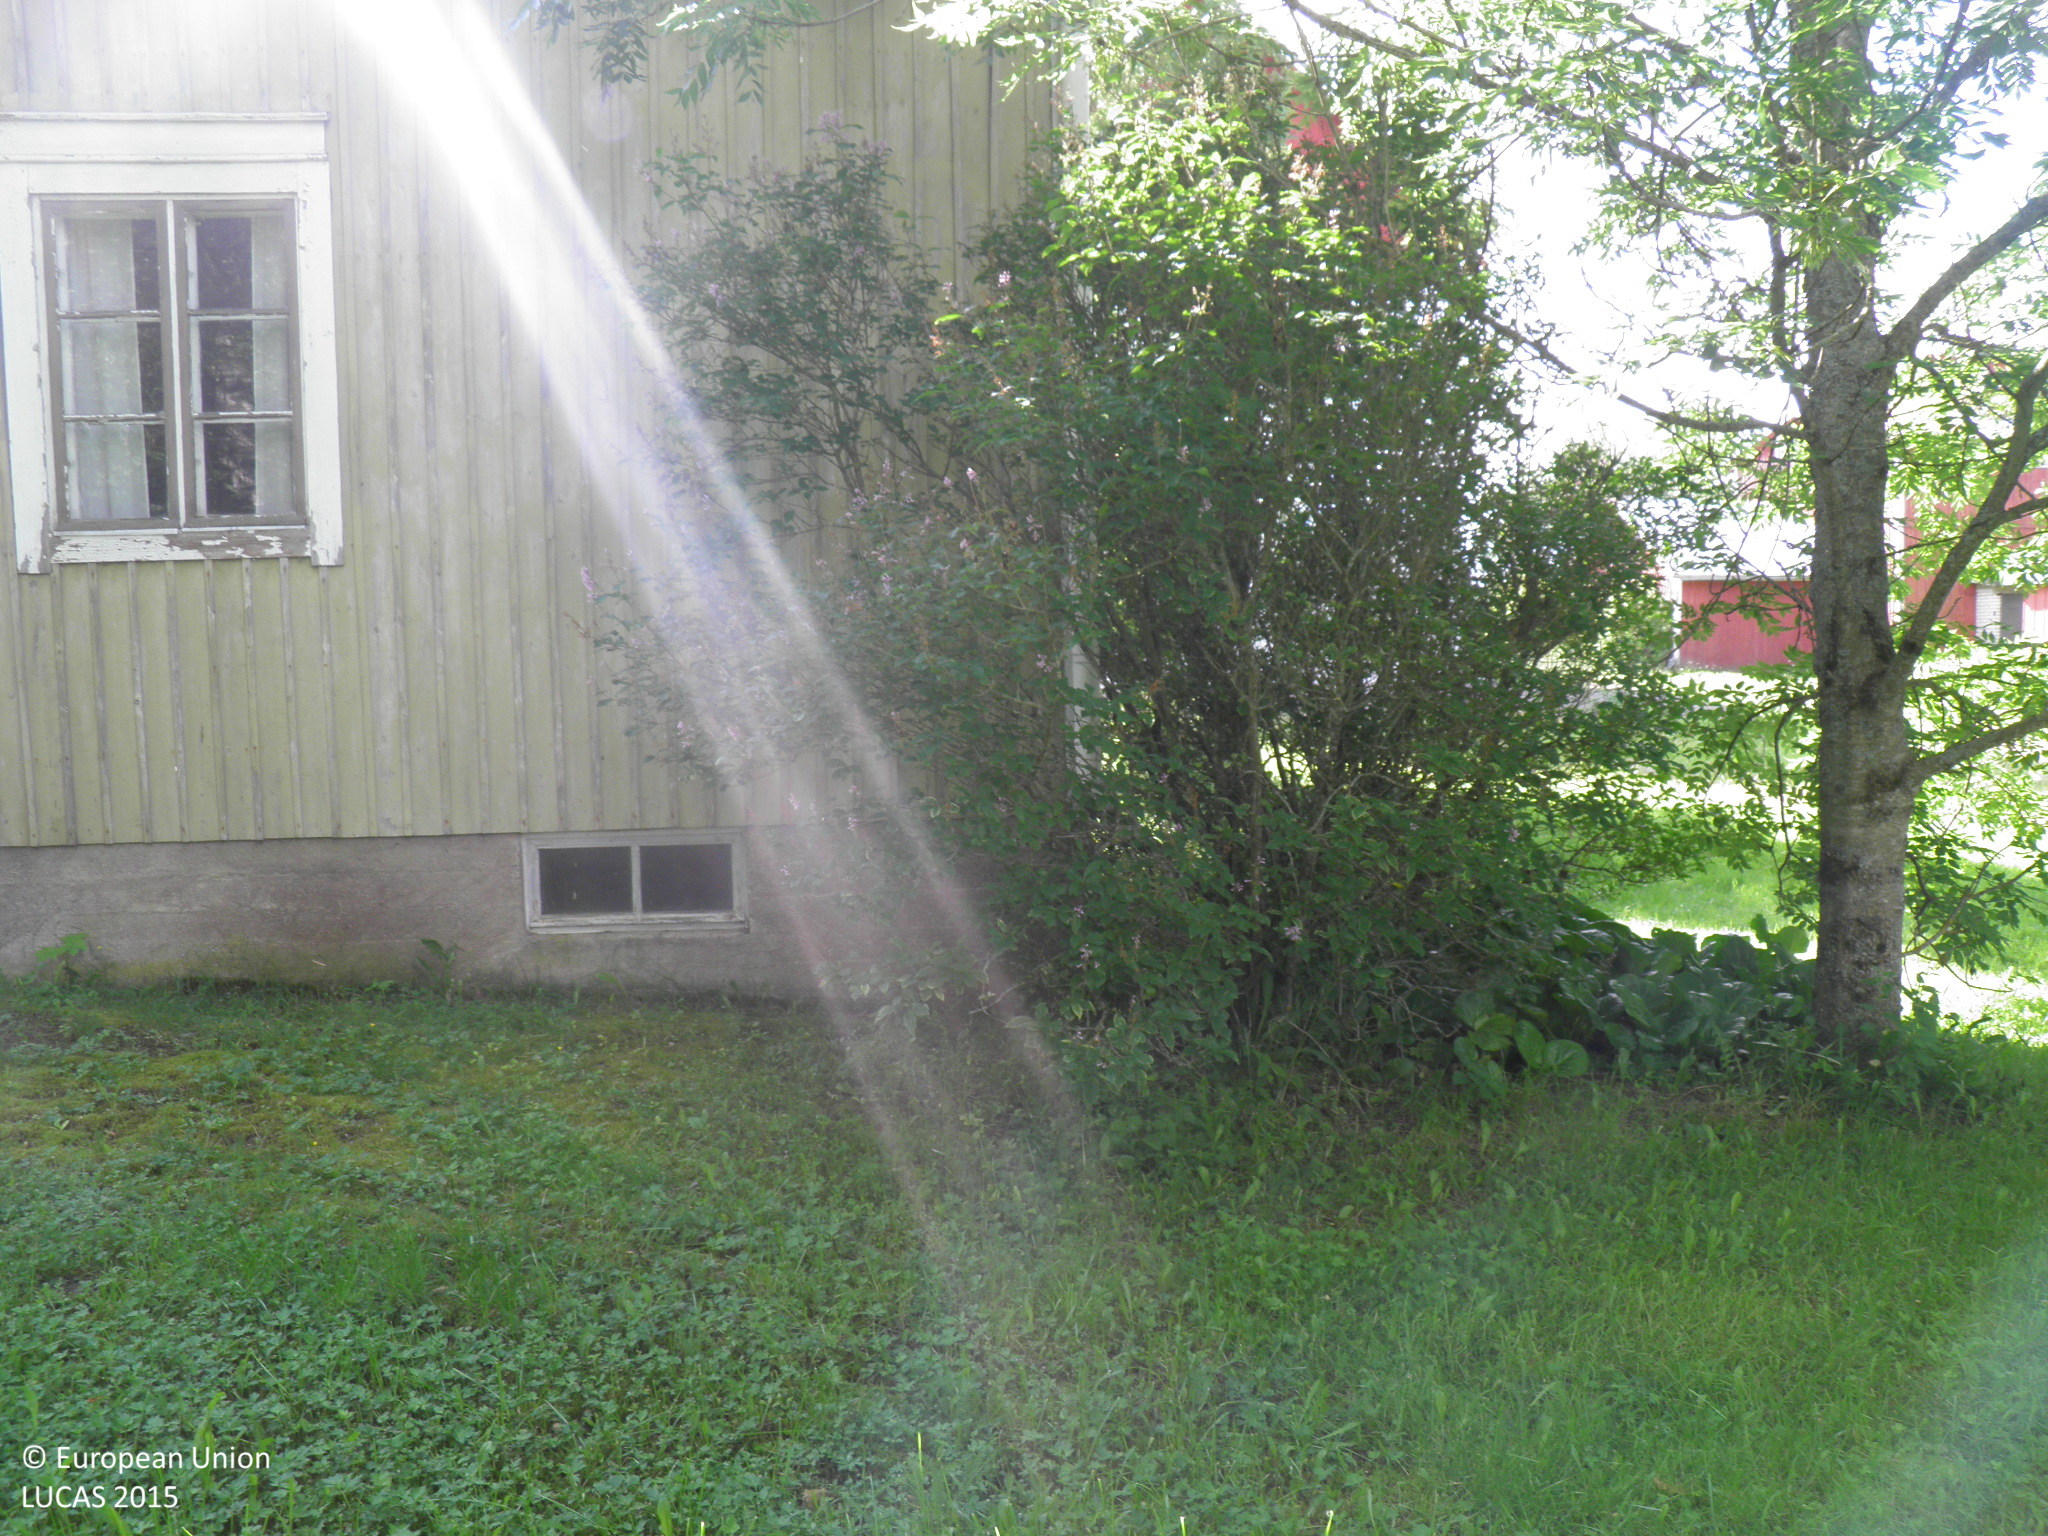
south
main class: Grassland
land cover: Grassland with sparse tree/shrub cover
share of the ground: > 75 %
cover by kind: herbaceous plants 95 %, broadleaved forest trees 5 %
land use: Residential
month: July
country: FI
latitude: 60.7904
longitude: 22.9154
